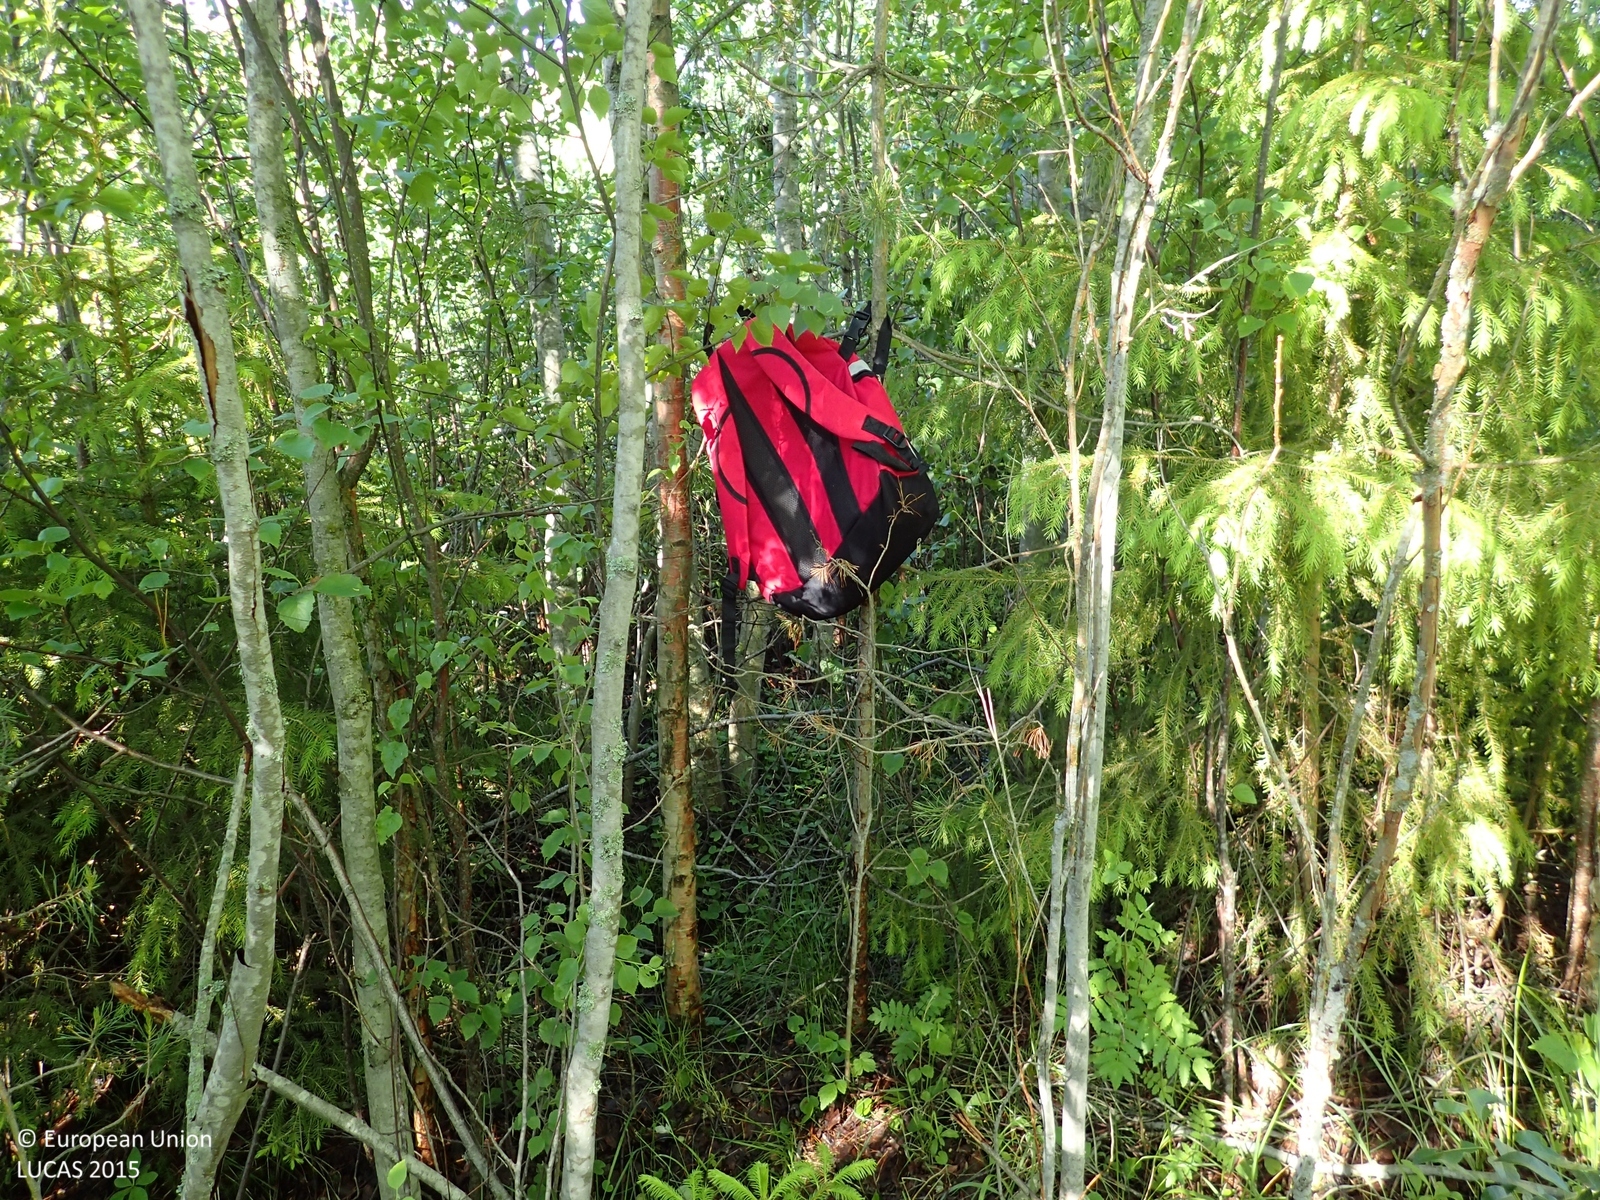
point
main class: Woodland
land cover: Broadleaved woodland
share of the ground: > 75 %
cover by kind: broadleaved forest trees 75 %, herbaceous plants 25 %
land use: Forestry
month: June
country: FI
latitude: 62.2848
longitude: 21.4351
